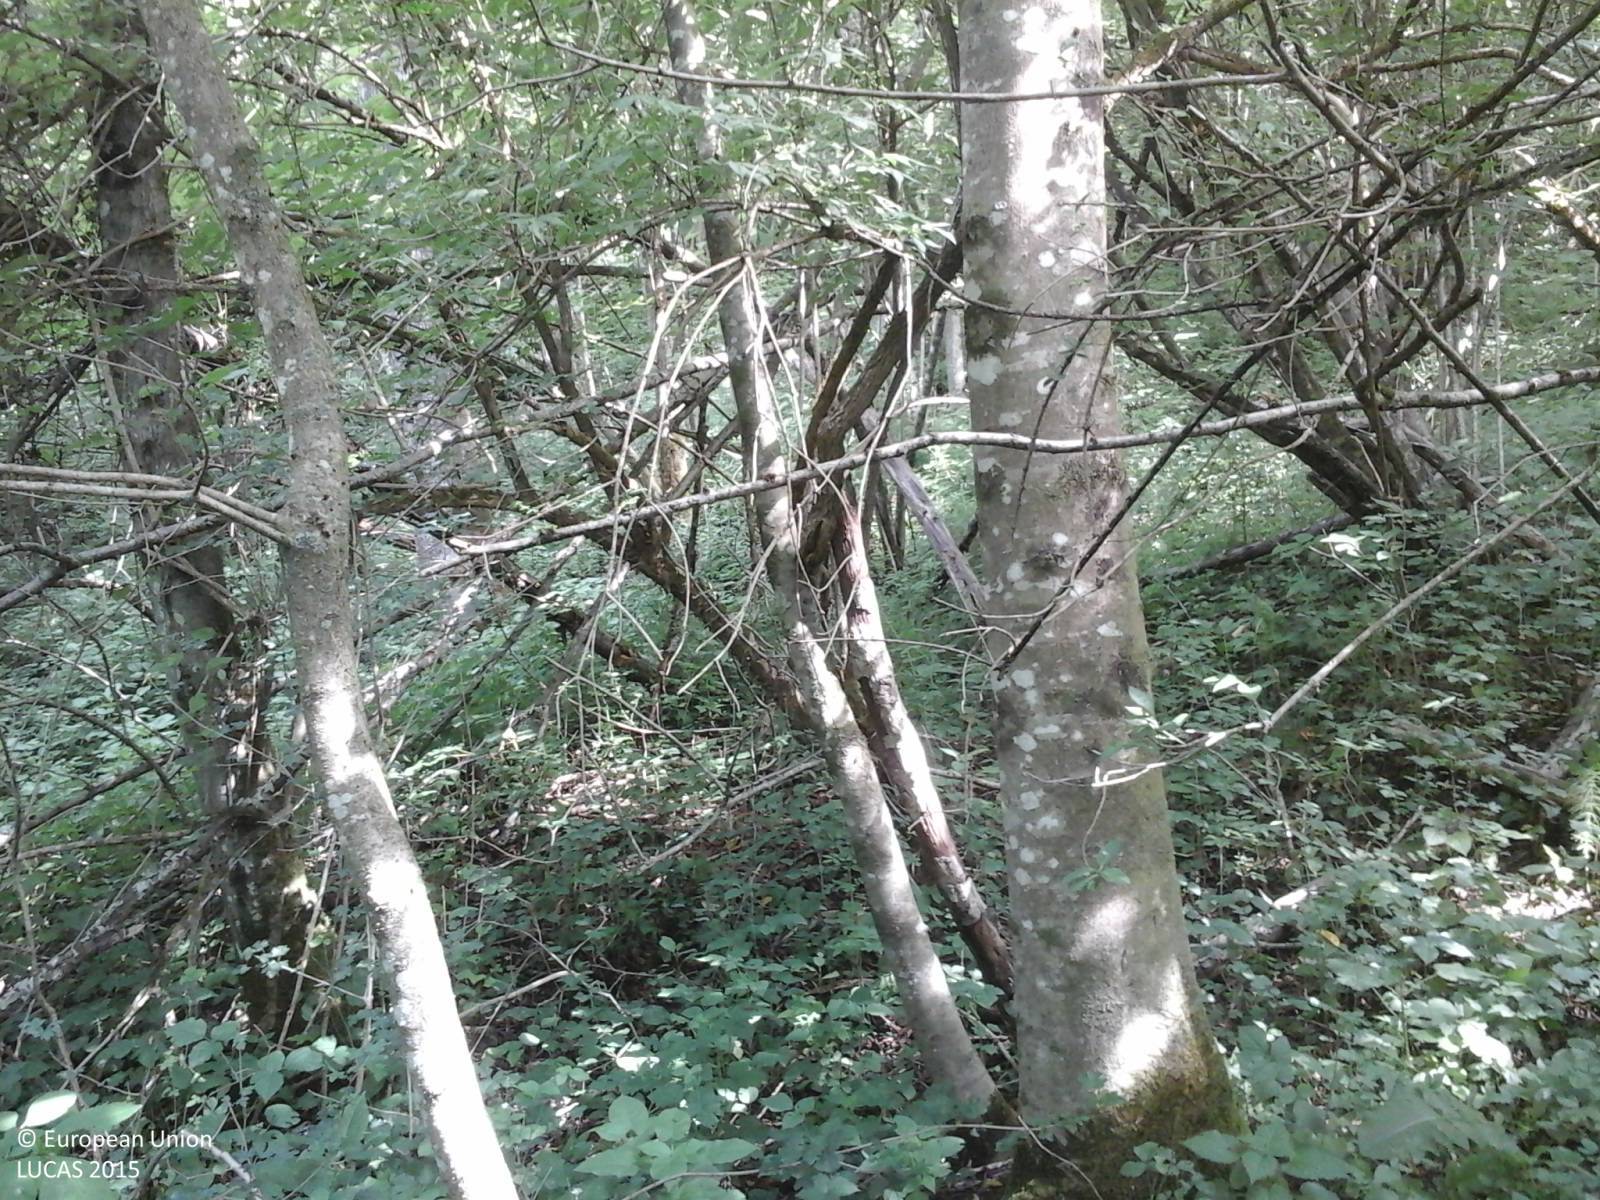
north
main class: Woodland
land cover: Broadleaved woodland
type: mesophytic deciduous forest
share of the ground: > 75 %
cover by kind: broadleaved forest trees 70 %, shrubs 20 %, herbaceous plants 10 %
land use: Forestry
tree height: > 5 m
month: July
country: IT
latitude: 46.1941
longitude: 12.5755
